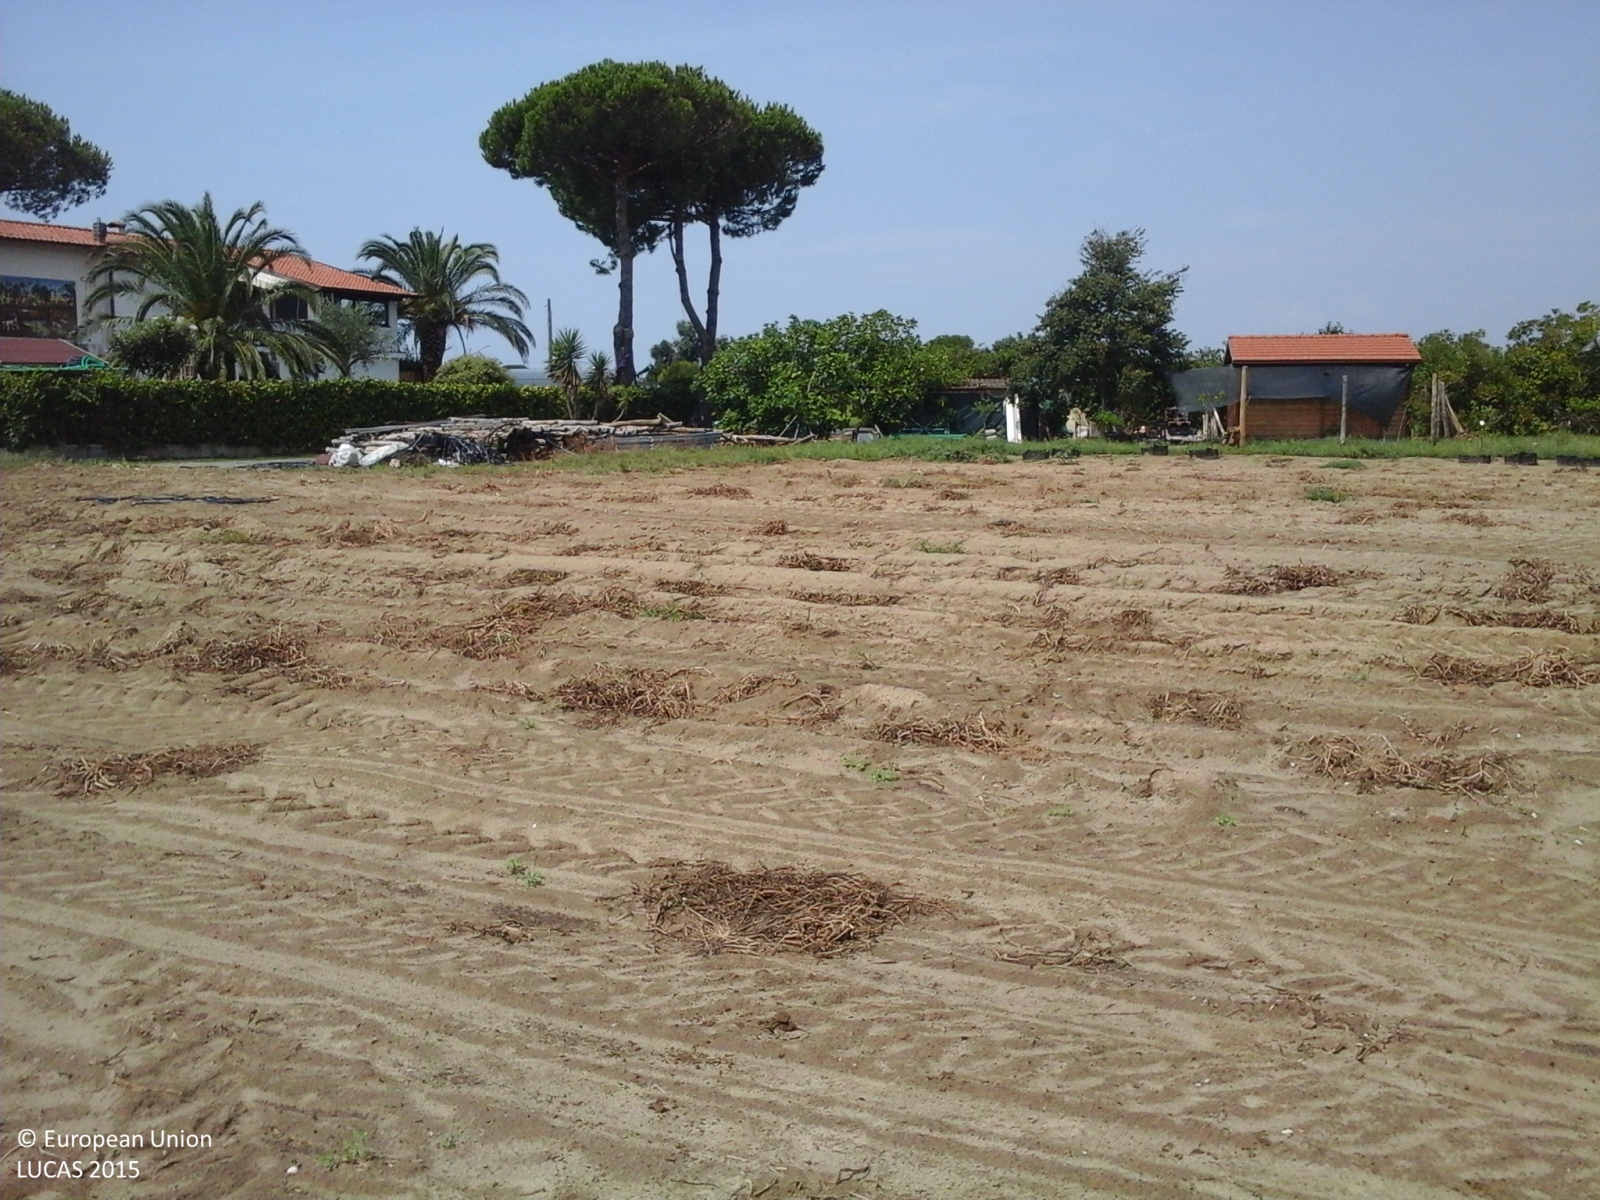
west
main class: Cropland
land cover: Potatoes
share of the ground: > 75 %
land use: Agriculture (excluding fallow land and kitchen gardens)
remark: Harvested field
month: August
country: IT
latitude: 43.9173
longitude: 10.2360
